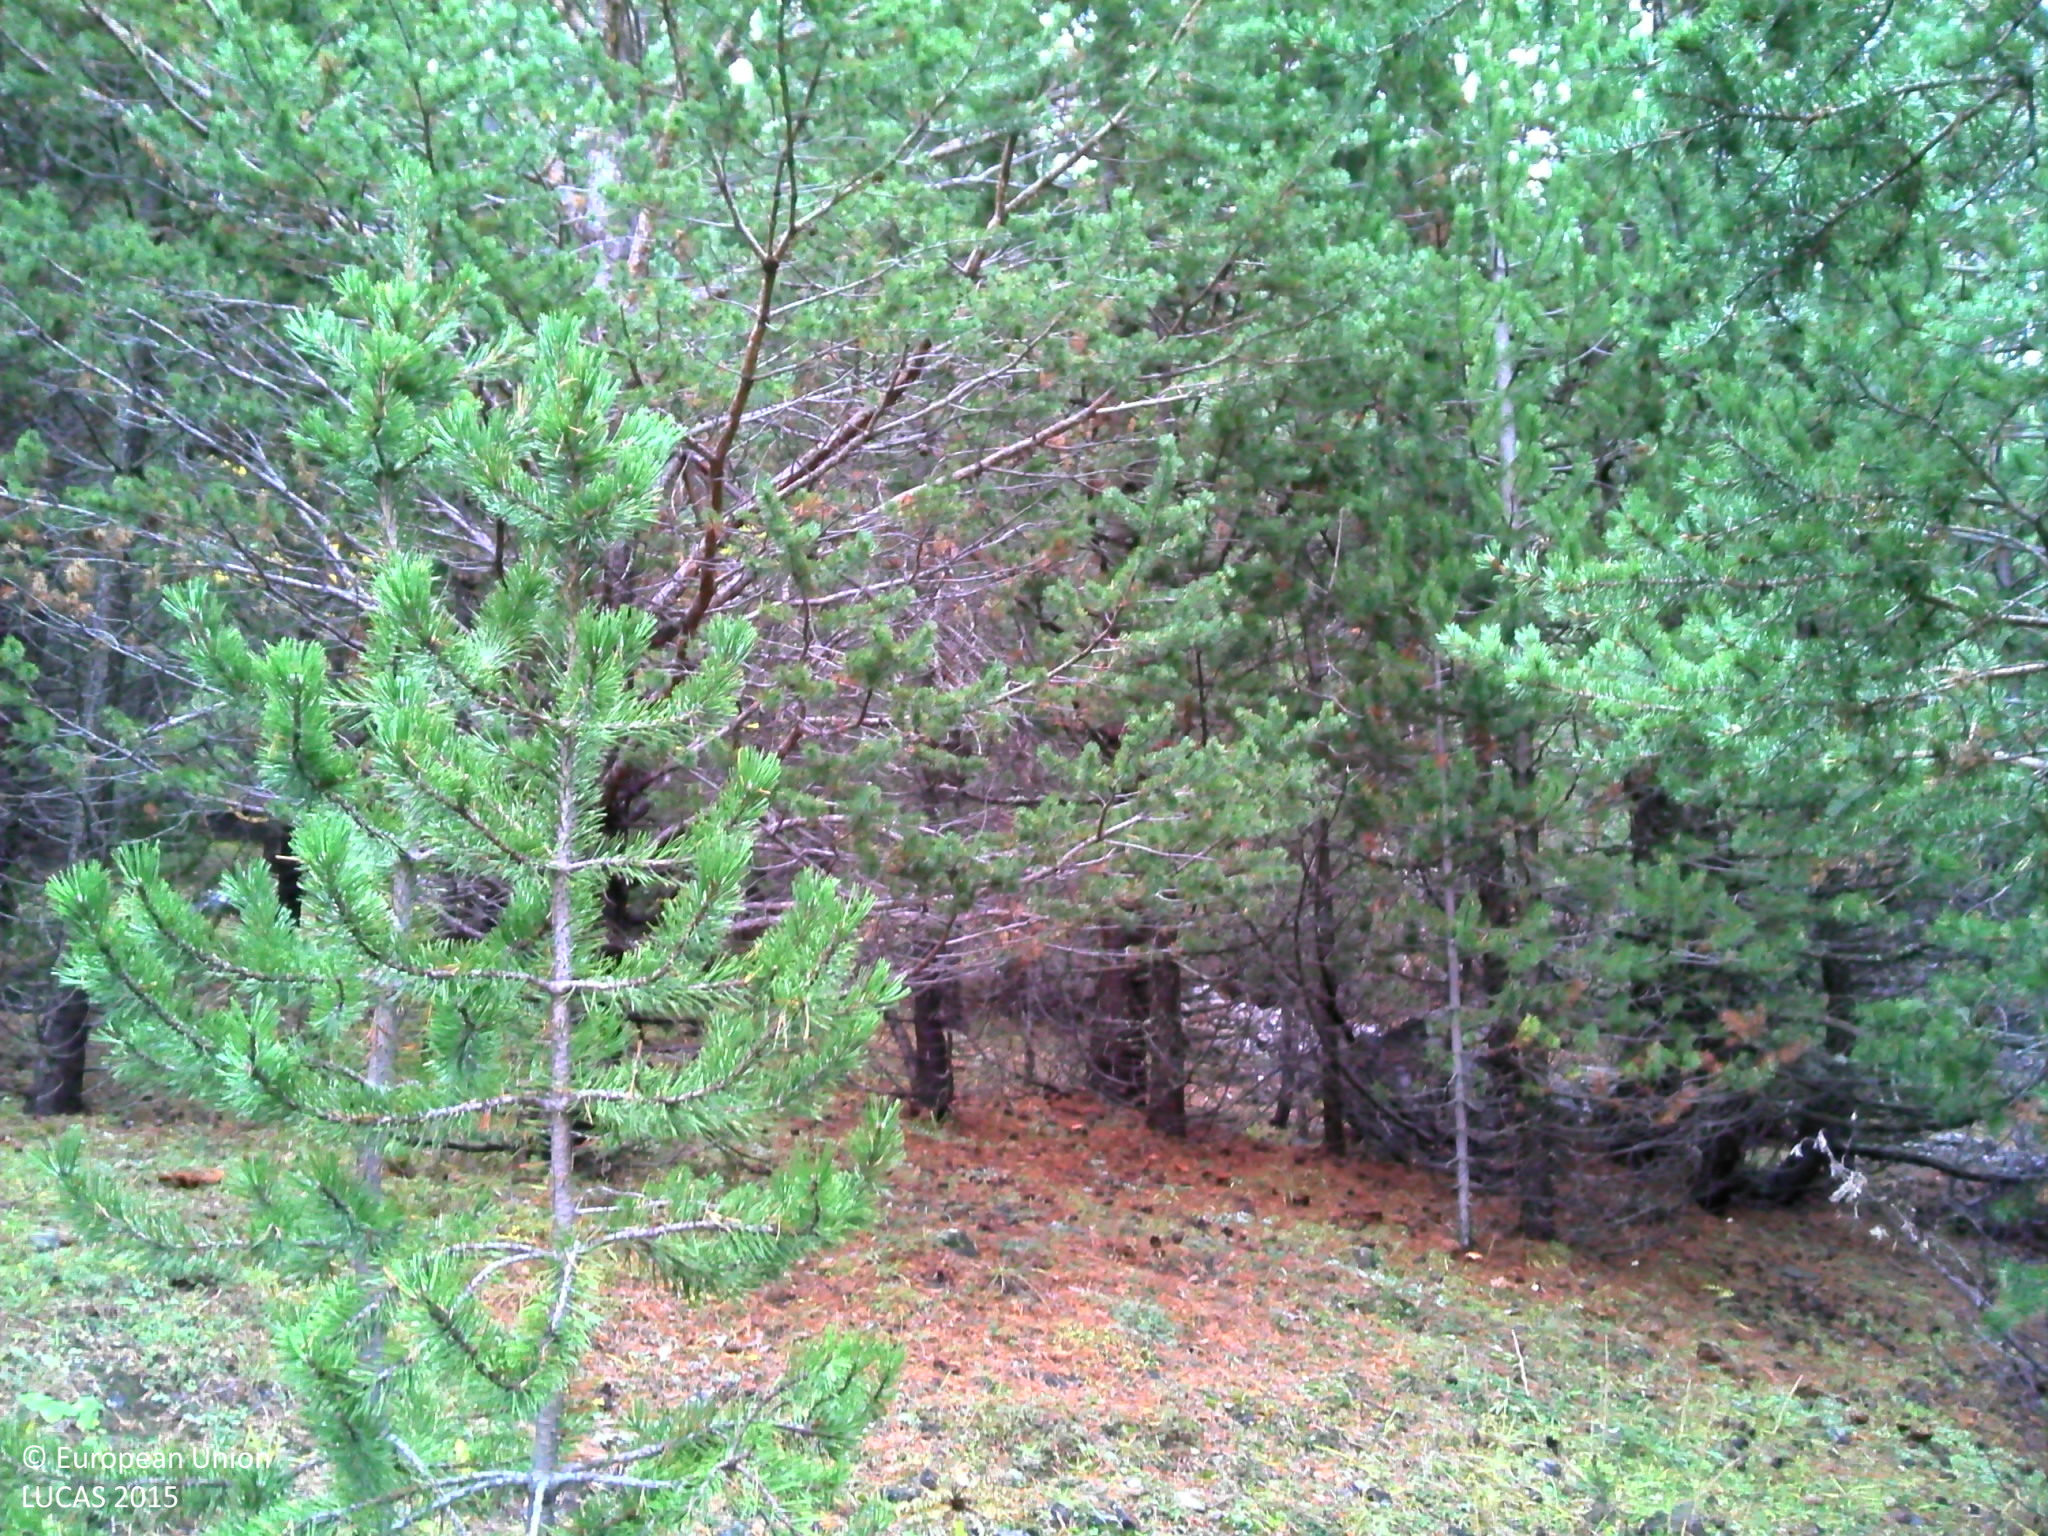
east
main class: Woodland
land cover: Pine dominated coniferous woodland
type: alpine coniferous forest
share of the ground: > 75 %
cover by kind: coniferous forest trees 70 %, herbaceous plants 15 %, consolidated bare surface 15 %
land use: Forestry
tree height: > 5 m
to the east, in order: Pine dominated coniferous woodland; Rock outcrops; Rivers and streams; Rock outcrops; Pine dominated coniferous woodland; Grassland with sparse tree/shrub cover; Pine dominated coniferous woodland
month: October
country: FR
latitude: 44.8584
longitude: 6.7279
